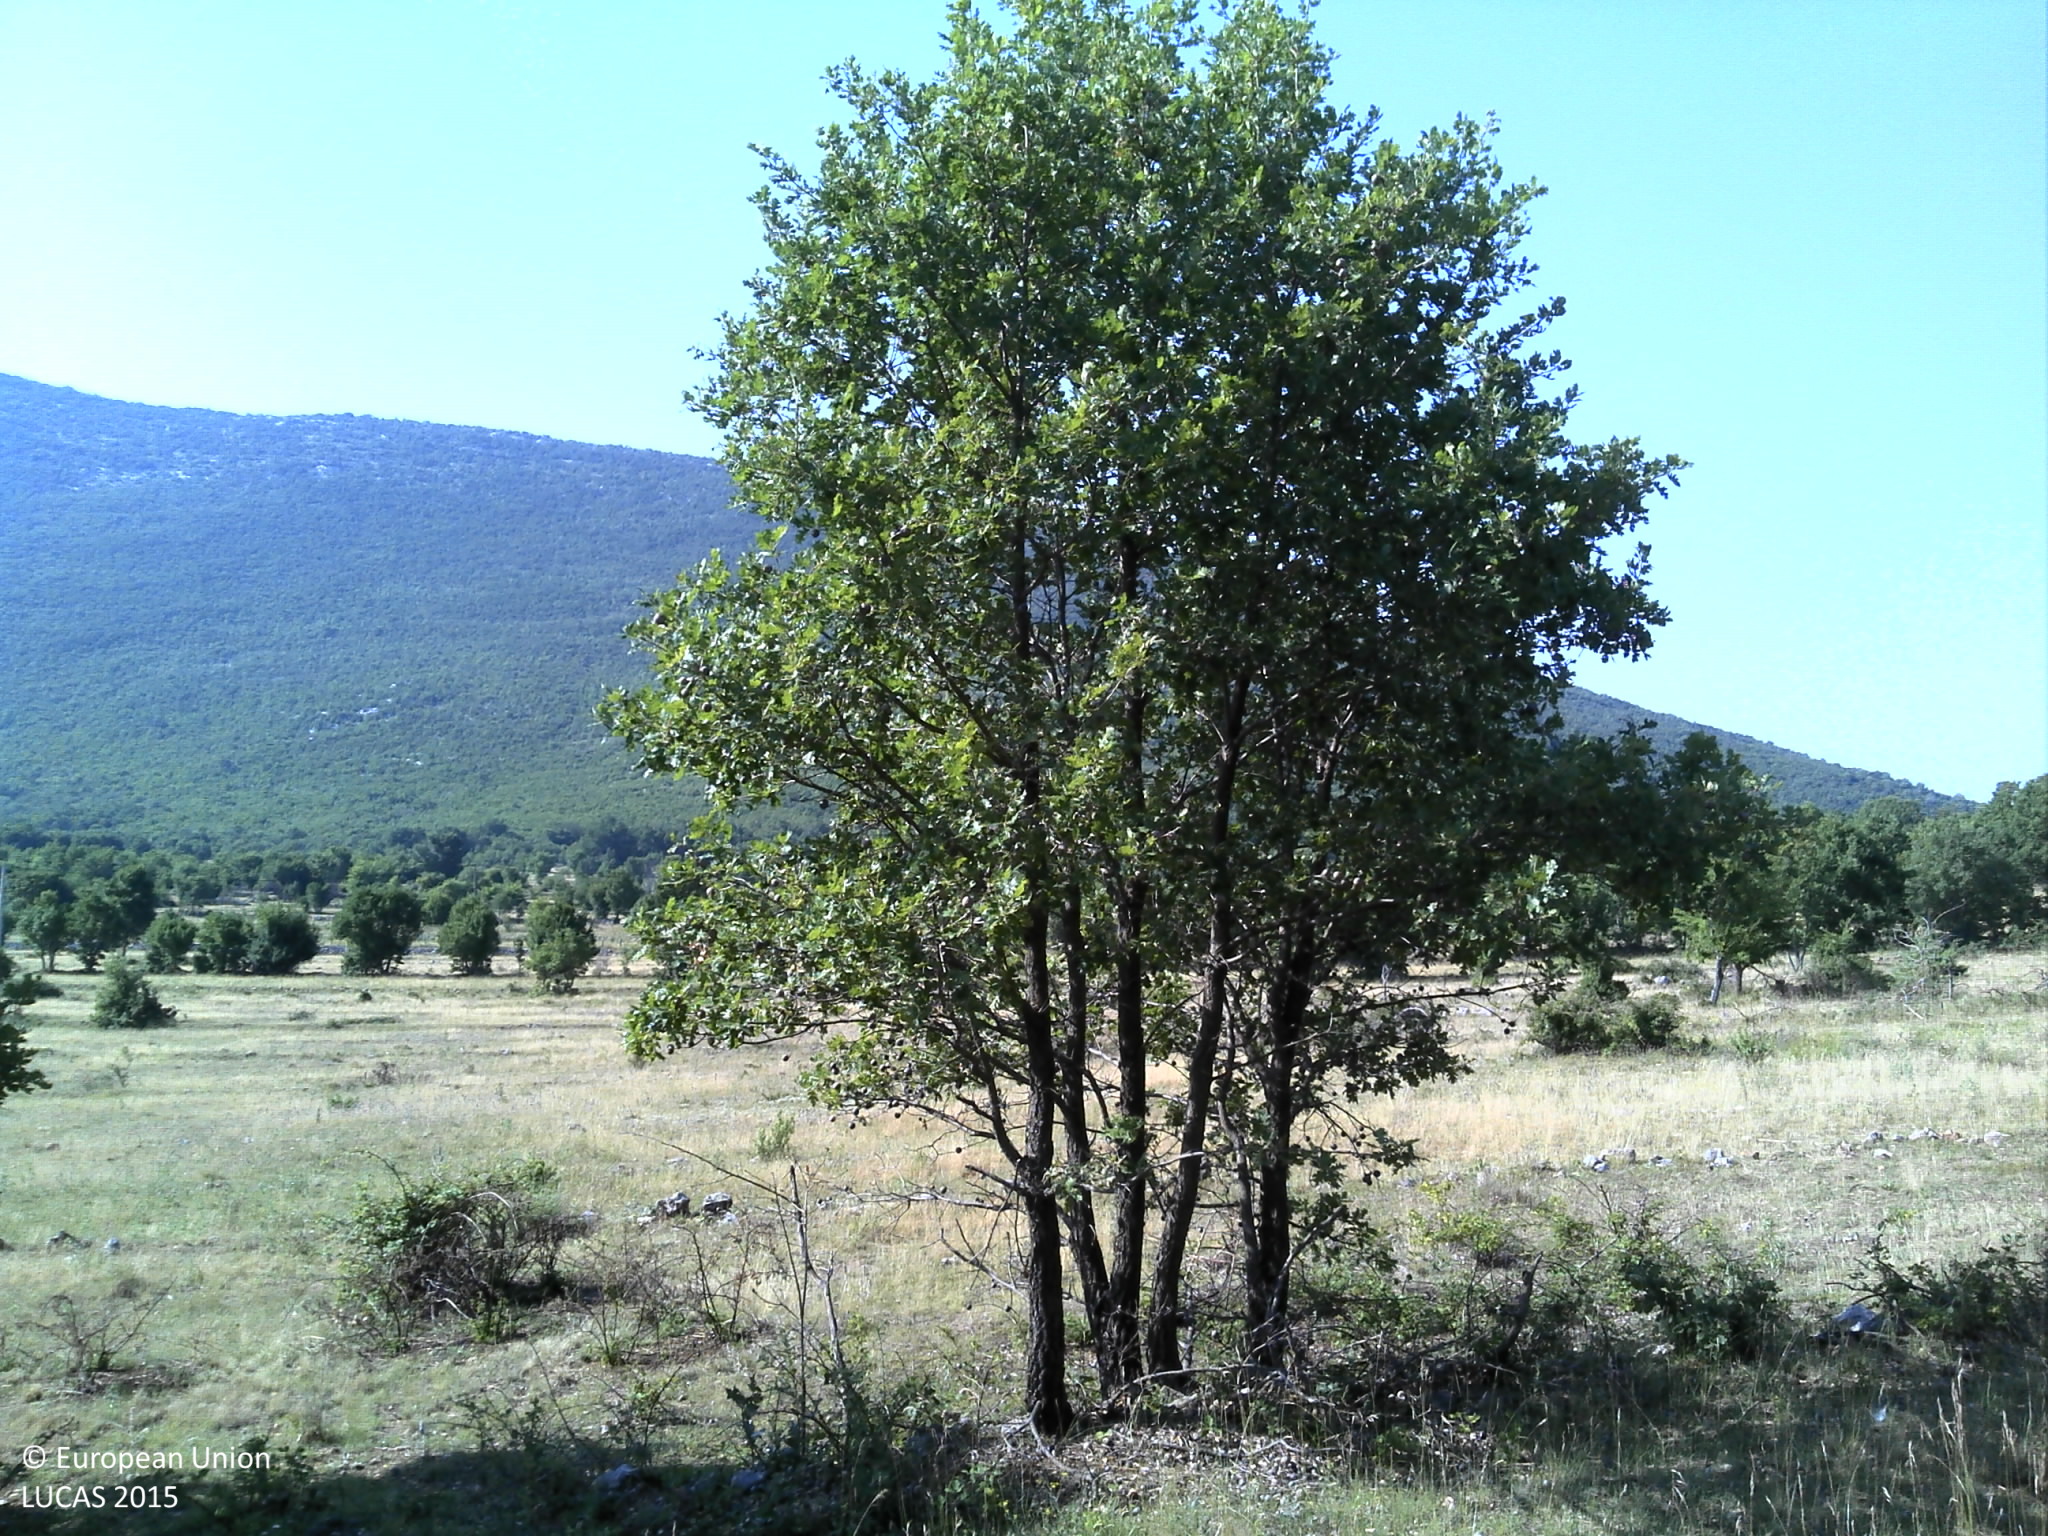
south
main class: Woodland
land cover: Broadleaved woodland
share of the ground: 25 - 50 %
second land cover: Grassland without tree/shrub cover
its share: 50 - 75 %
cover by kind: herbaceous plants 50 %, broadleaved forest trees 30 %, shrubs 20 %
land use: Forestry
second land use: Agriculture (excluding fallow land and kitchen gardens)
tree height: > 5 m
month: July
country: HR
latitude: 43.9789
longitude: 16.2880
